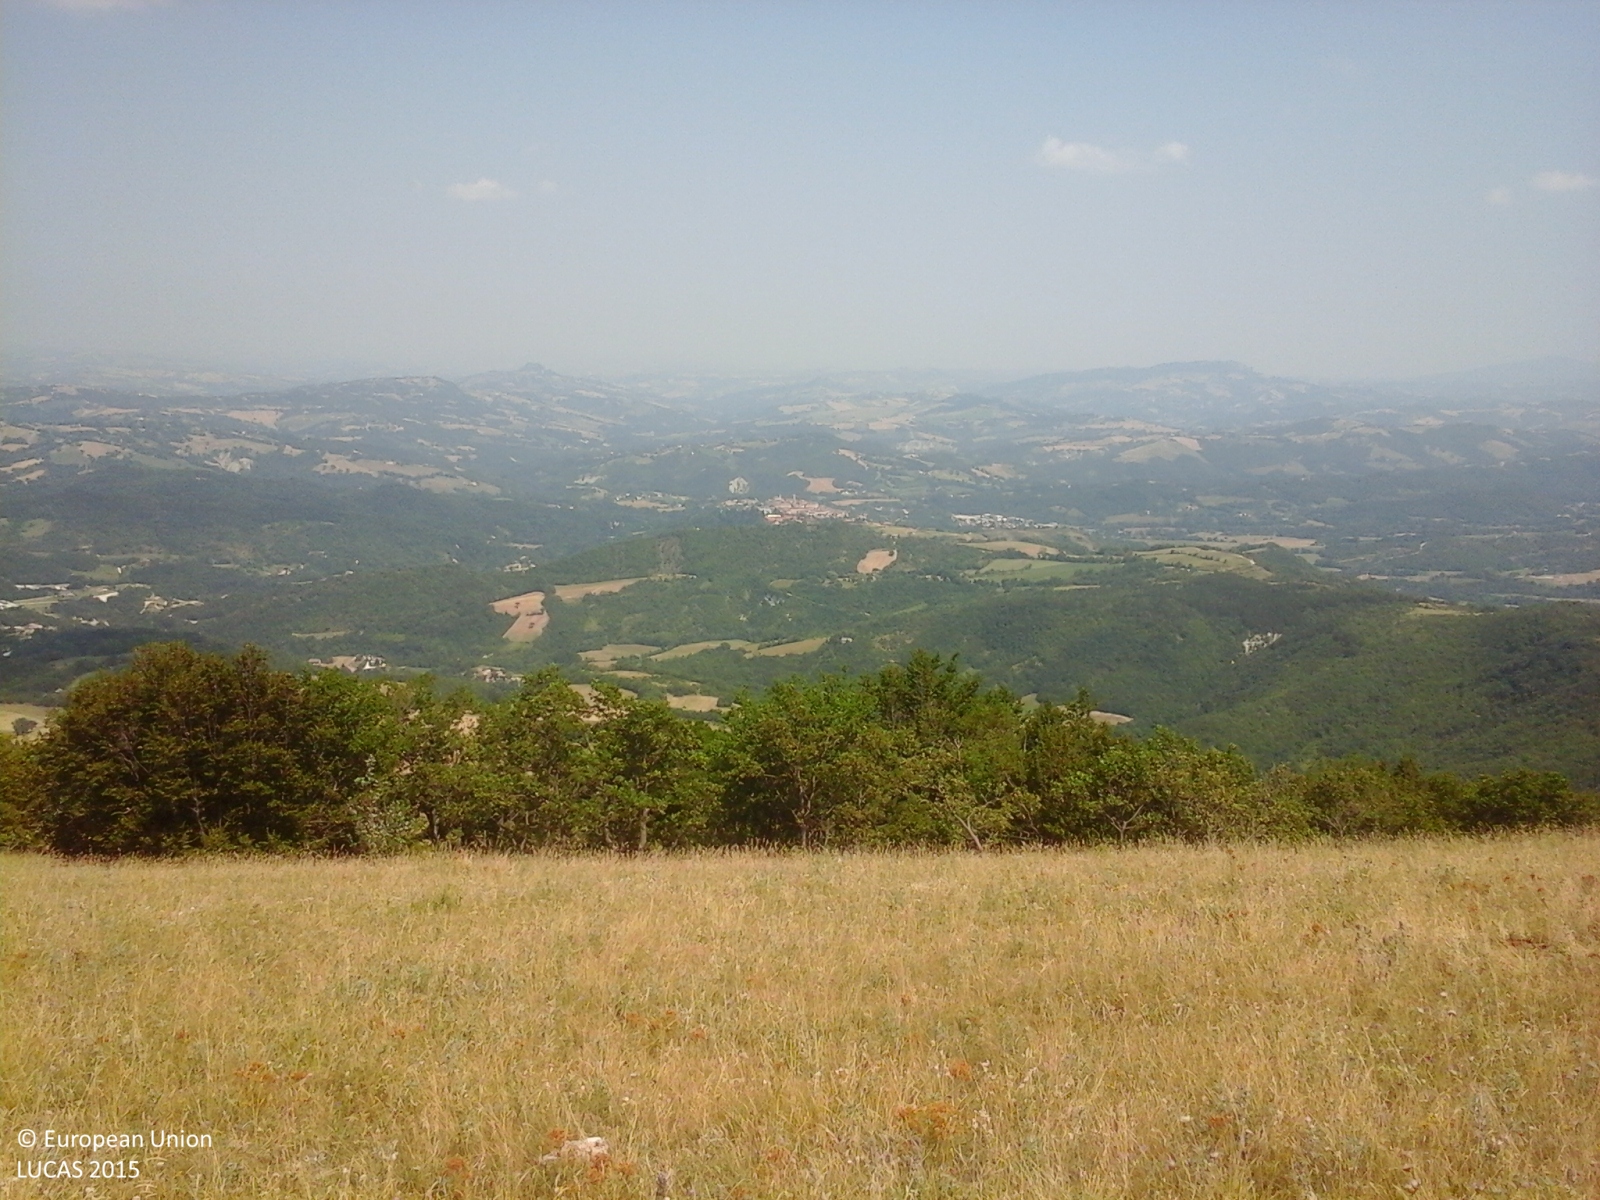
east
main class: Grassland
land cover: Grassland without tree/shrub cover
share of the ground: > 75 %
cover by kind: herbaceous plants 95 %, shrubs 5 %
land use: Agriculture (excluding fallow land and kitchen gardens)
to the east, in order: Grassland without tree/shrub cover; Broadleaved woodland
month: July
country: IT
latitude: 43.0358
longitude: 13.2435
